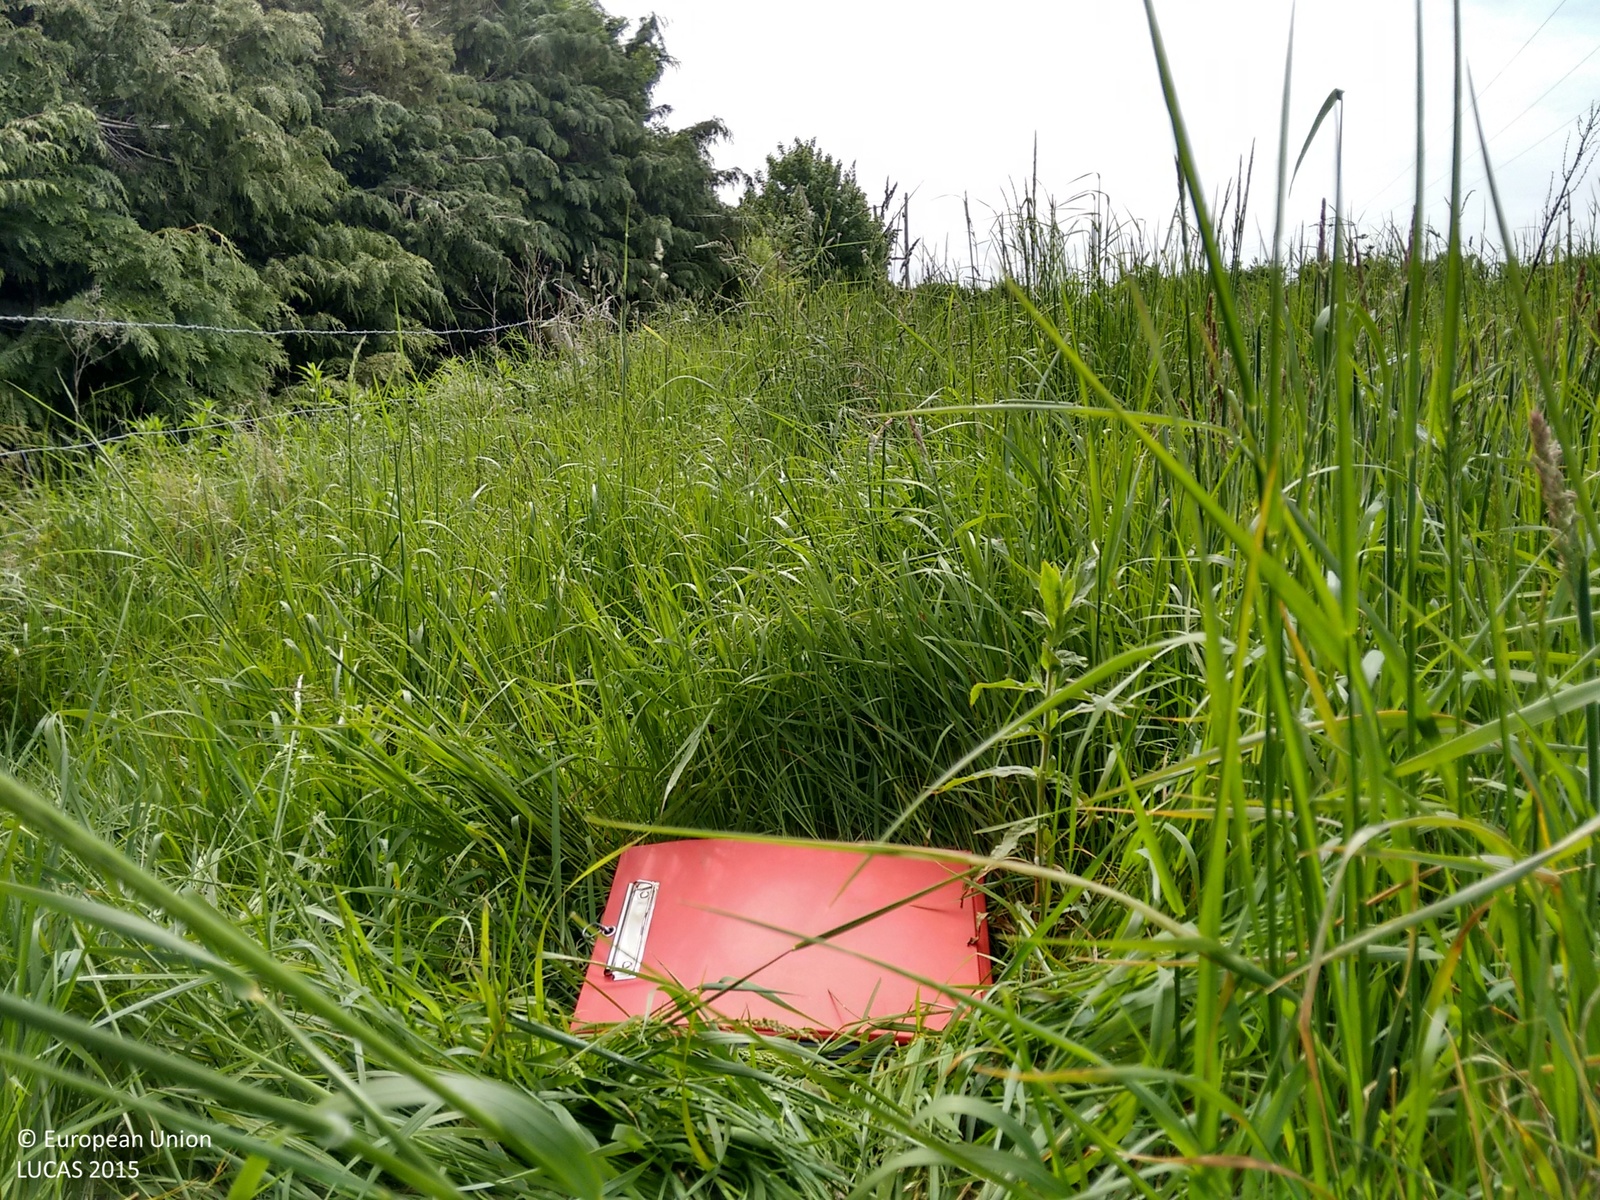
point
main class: Grassland
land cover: Grassland without tree/shrub cover
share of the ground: > 75 %
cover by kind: herbaceous plants 60 %, shrubs 5 %
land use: Agriculture (excluding fallow land and kitchen gardens)
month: June
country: IE
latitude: 53.2312
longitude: -6.9027
